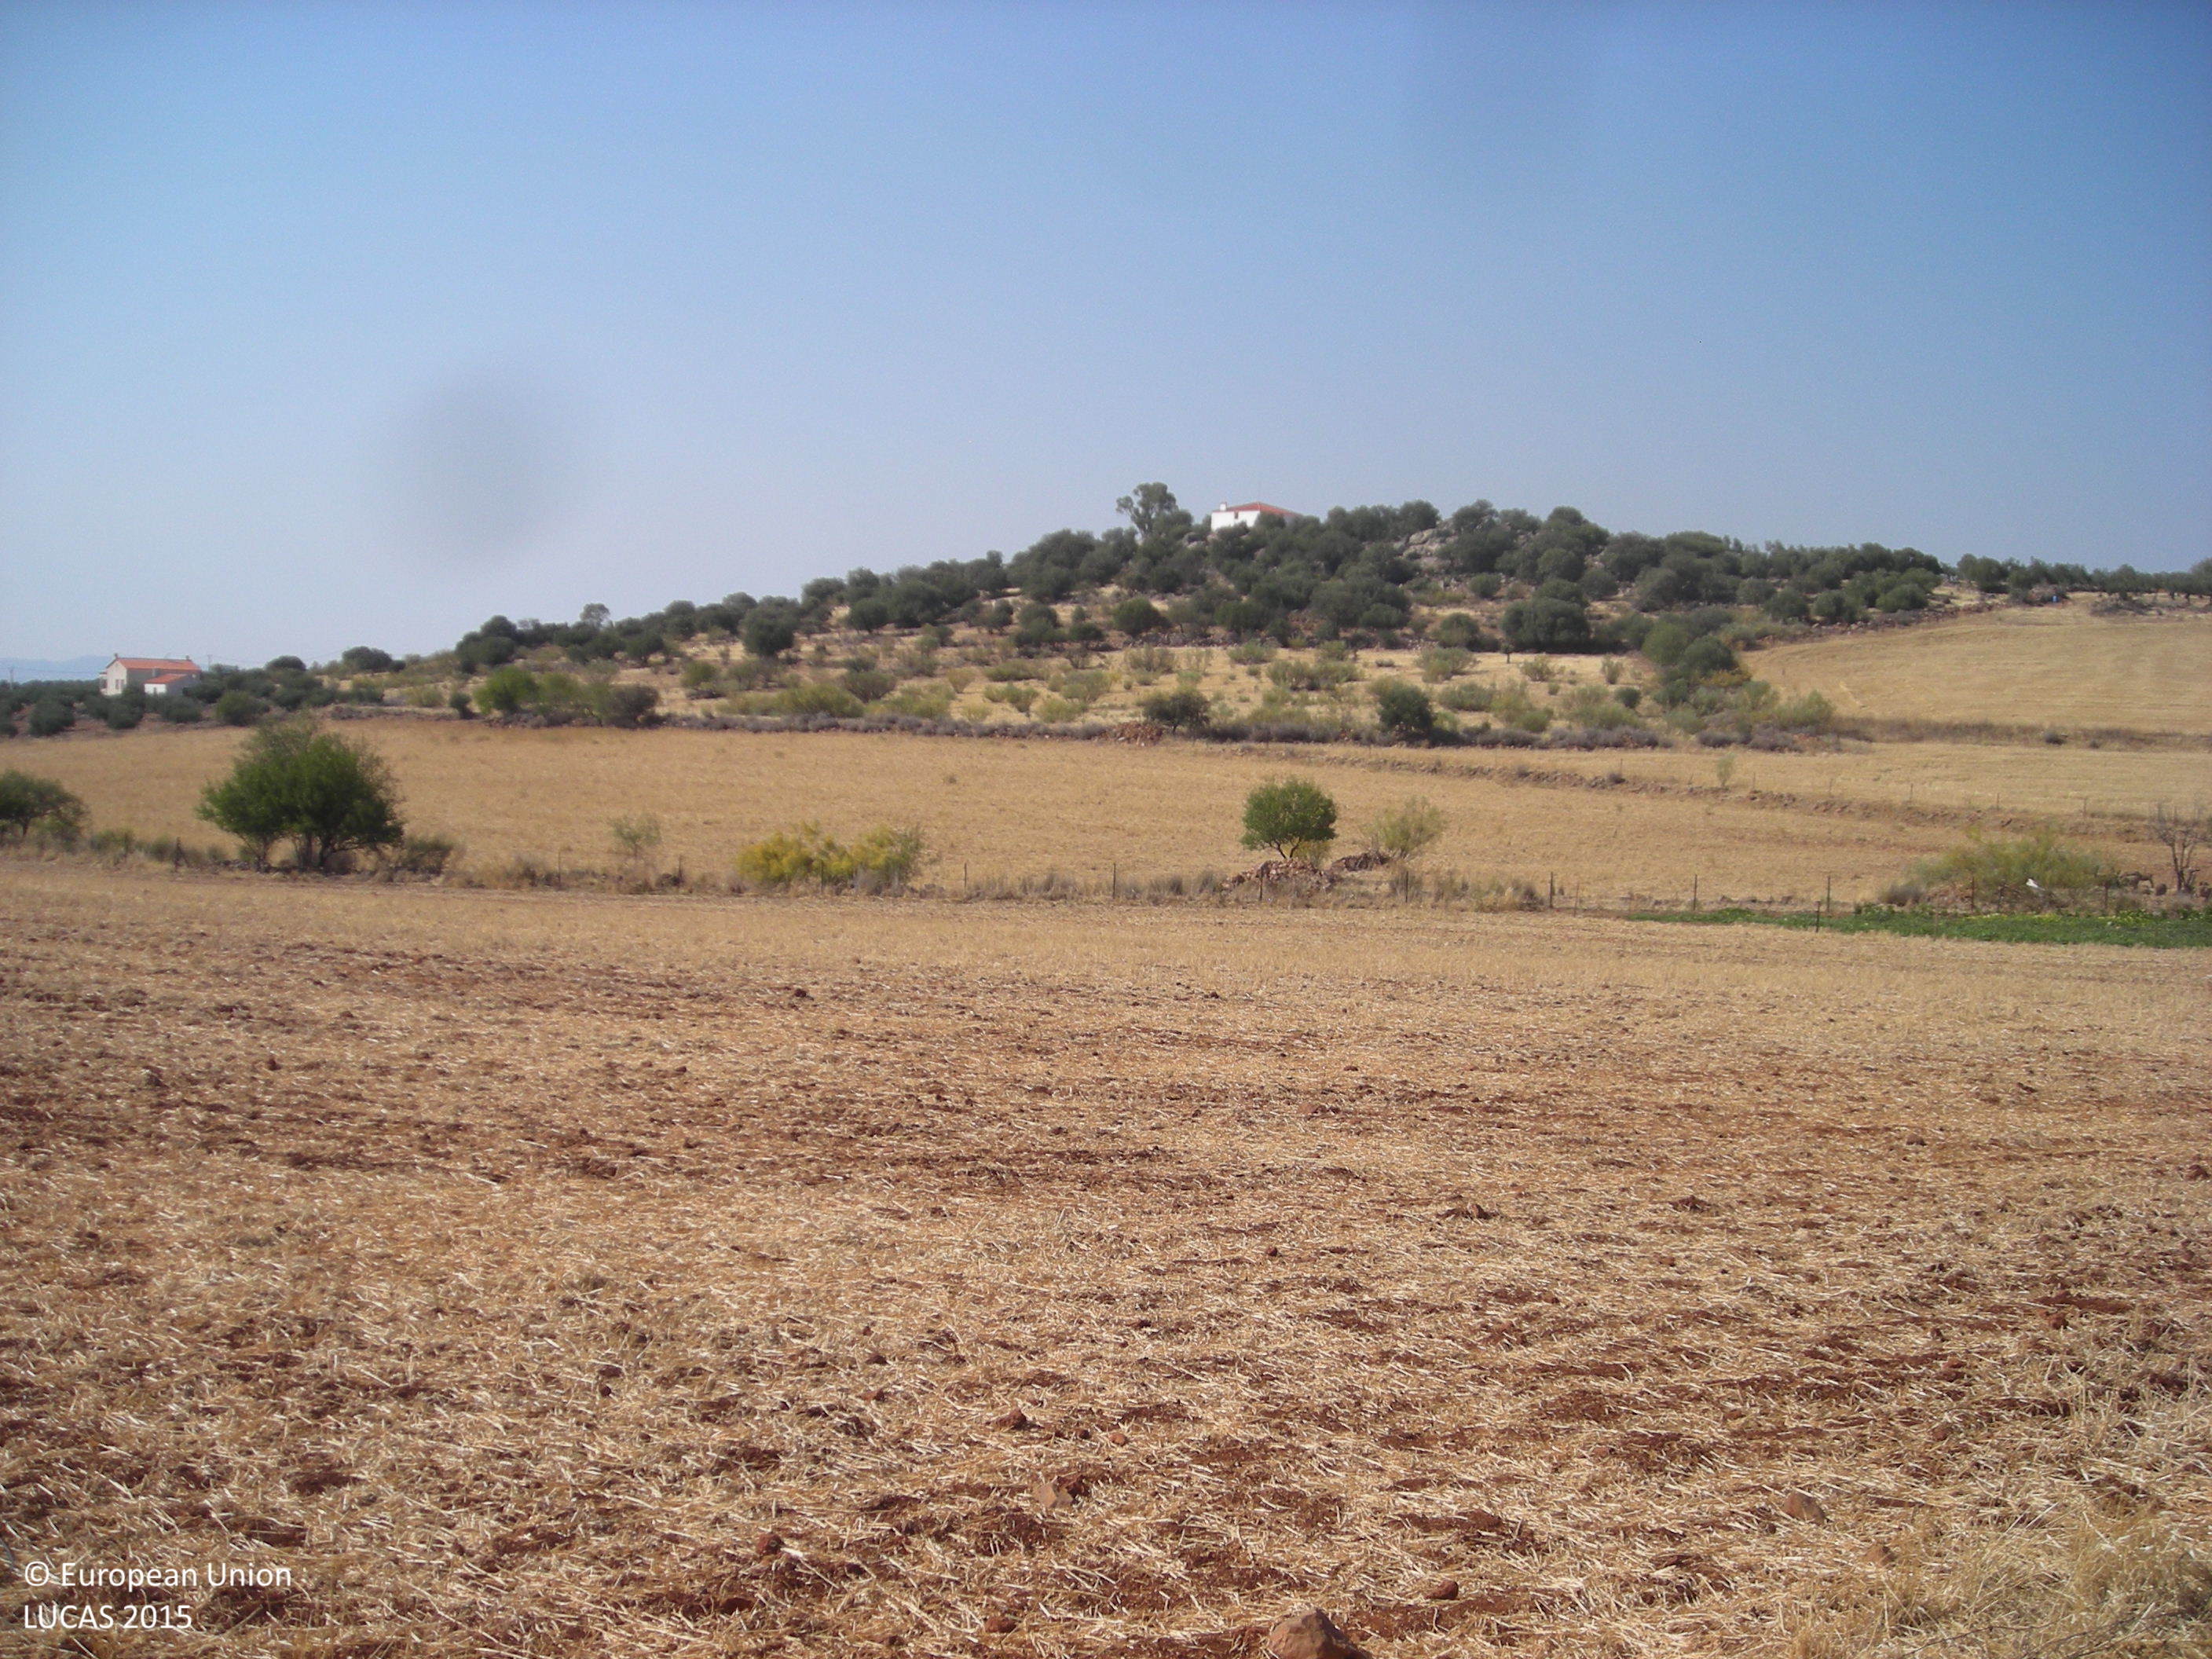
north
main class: Cropland
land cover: Olive groves
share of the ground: 25 - 50 %
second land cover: Other bare soil
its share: > 75 %
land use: Agriculture (excluding fallow land and kitchen gardens)
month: July
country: ES
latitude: 38.9101
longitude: -5.7651
